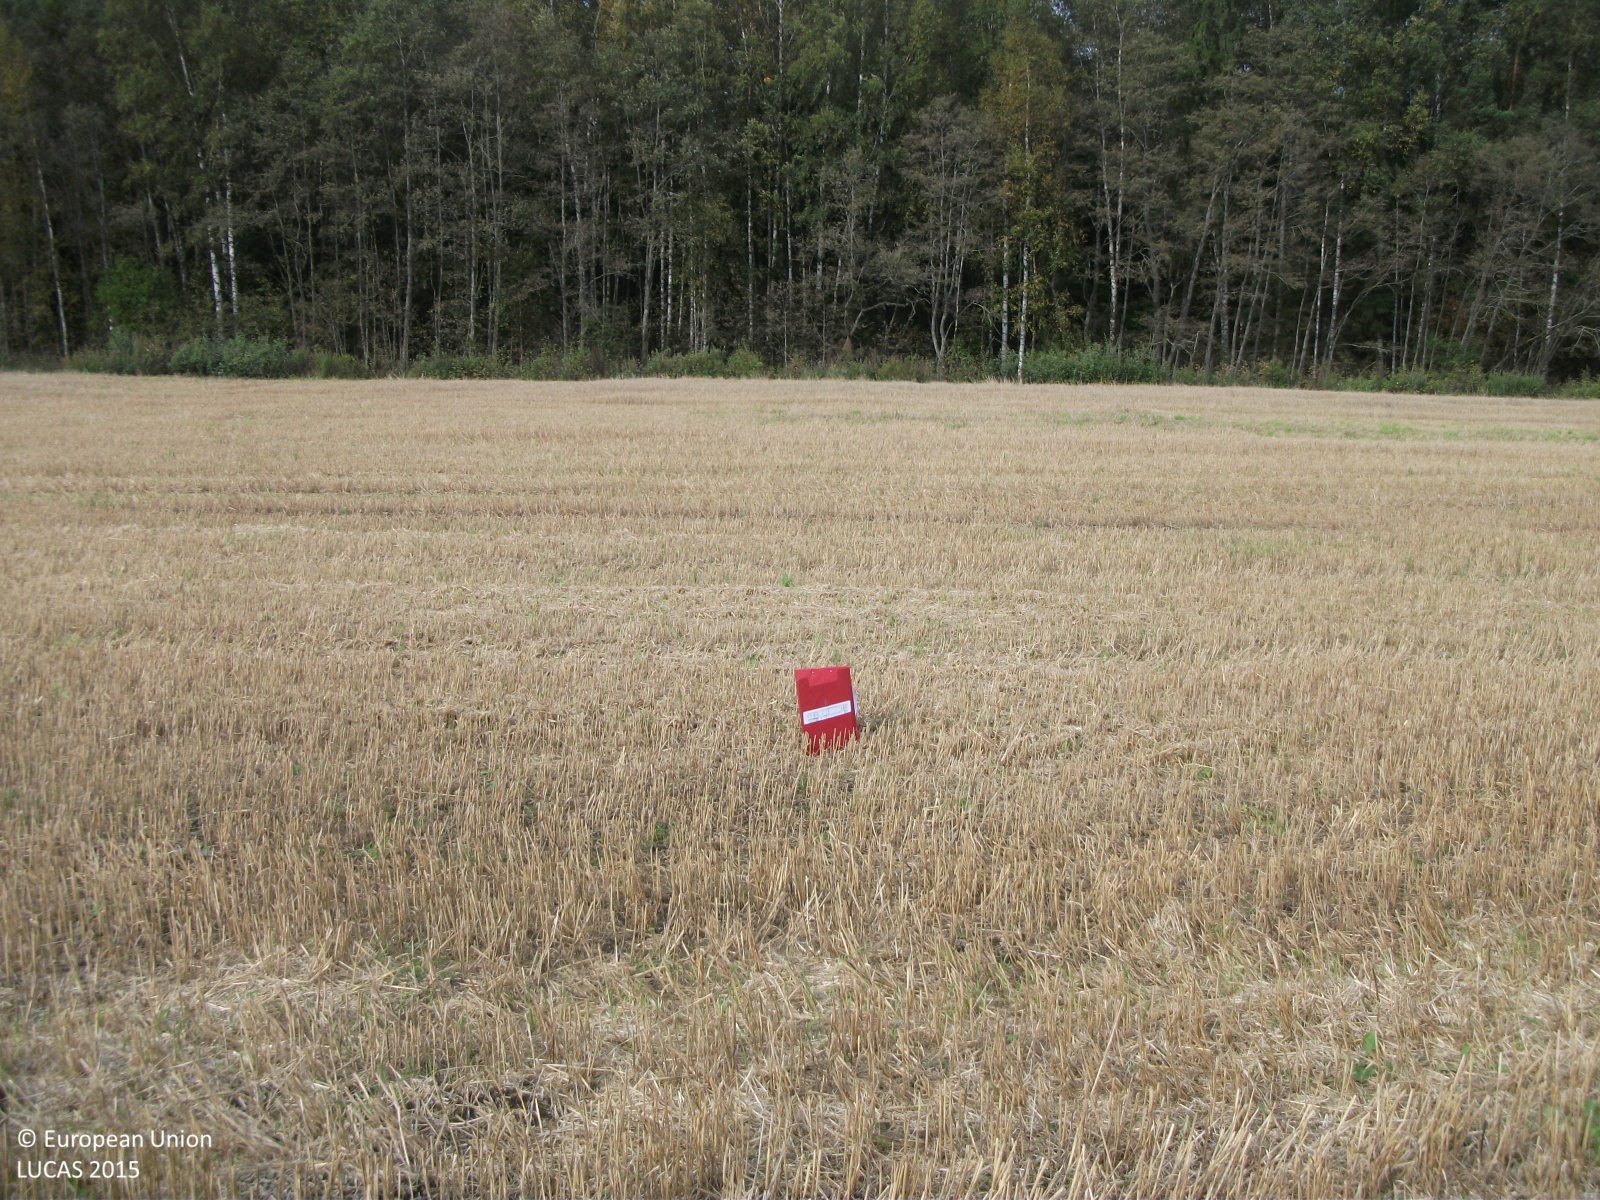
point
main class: Cropland
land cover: Common wheat
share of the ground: < 10 %
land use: Agriculture (excluding fallow land and kitchen gardens)
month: September
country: LV
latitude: 57.7073
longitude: 24.7810
